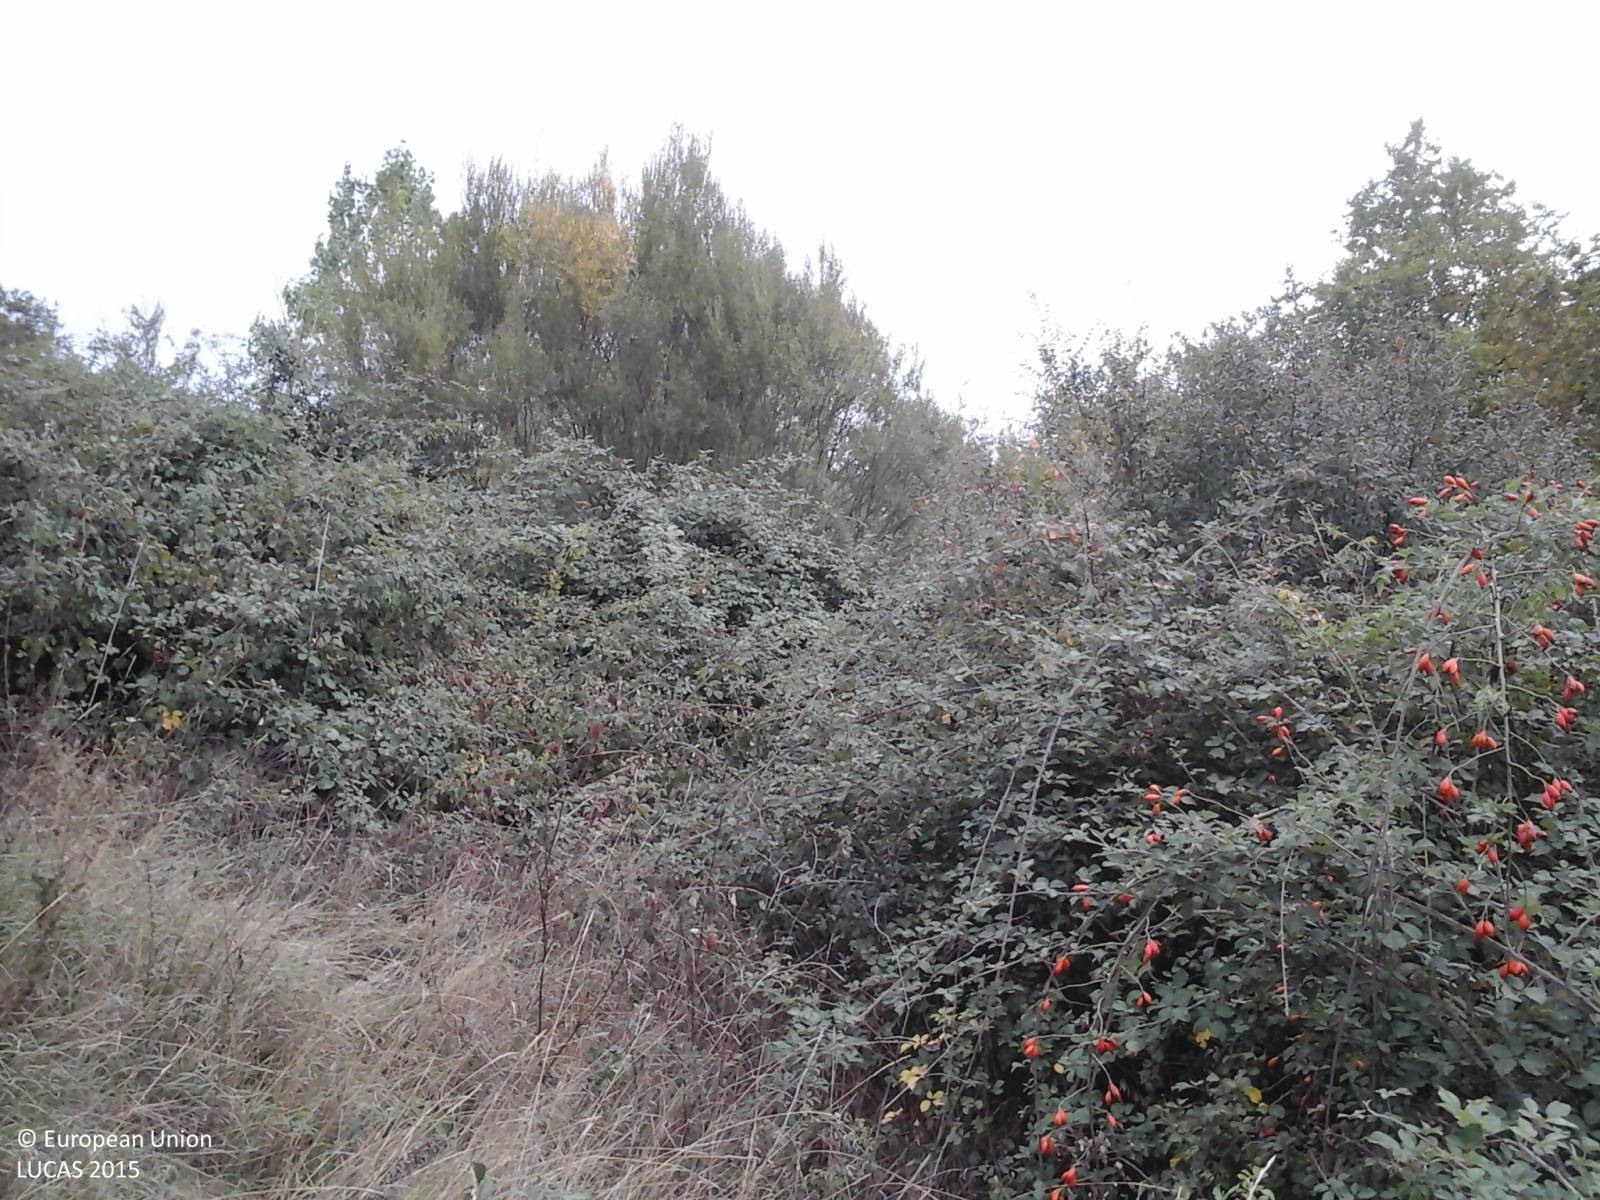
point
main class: Woodland
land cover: Broadleaved woodland
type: thermophilous deciduous forest
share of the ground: > 75 %
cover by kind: broadleaved forest trees 60 %, shrubs 40 %
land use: Forestry
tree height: > 5 m
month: September
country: IT
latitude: 42.9540
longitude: 12.2608
